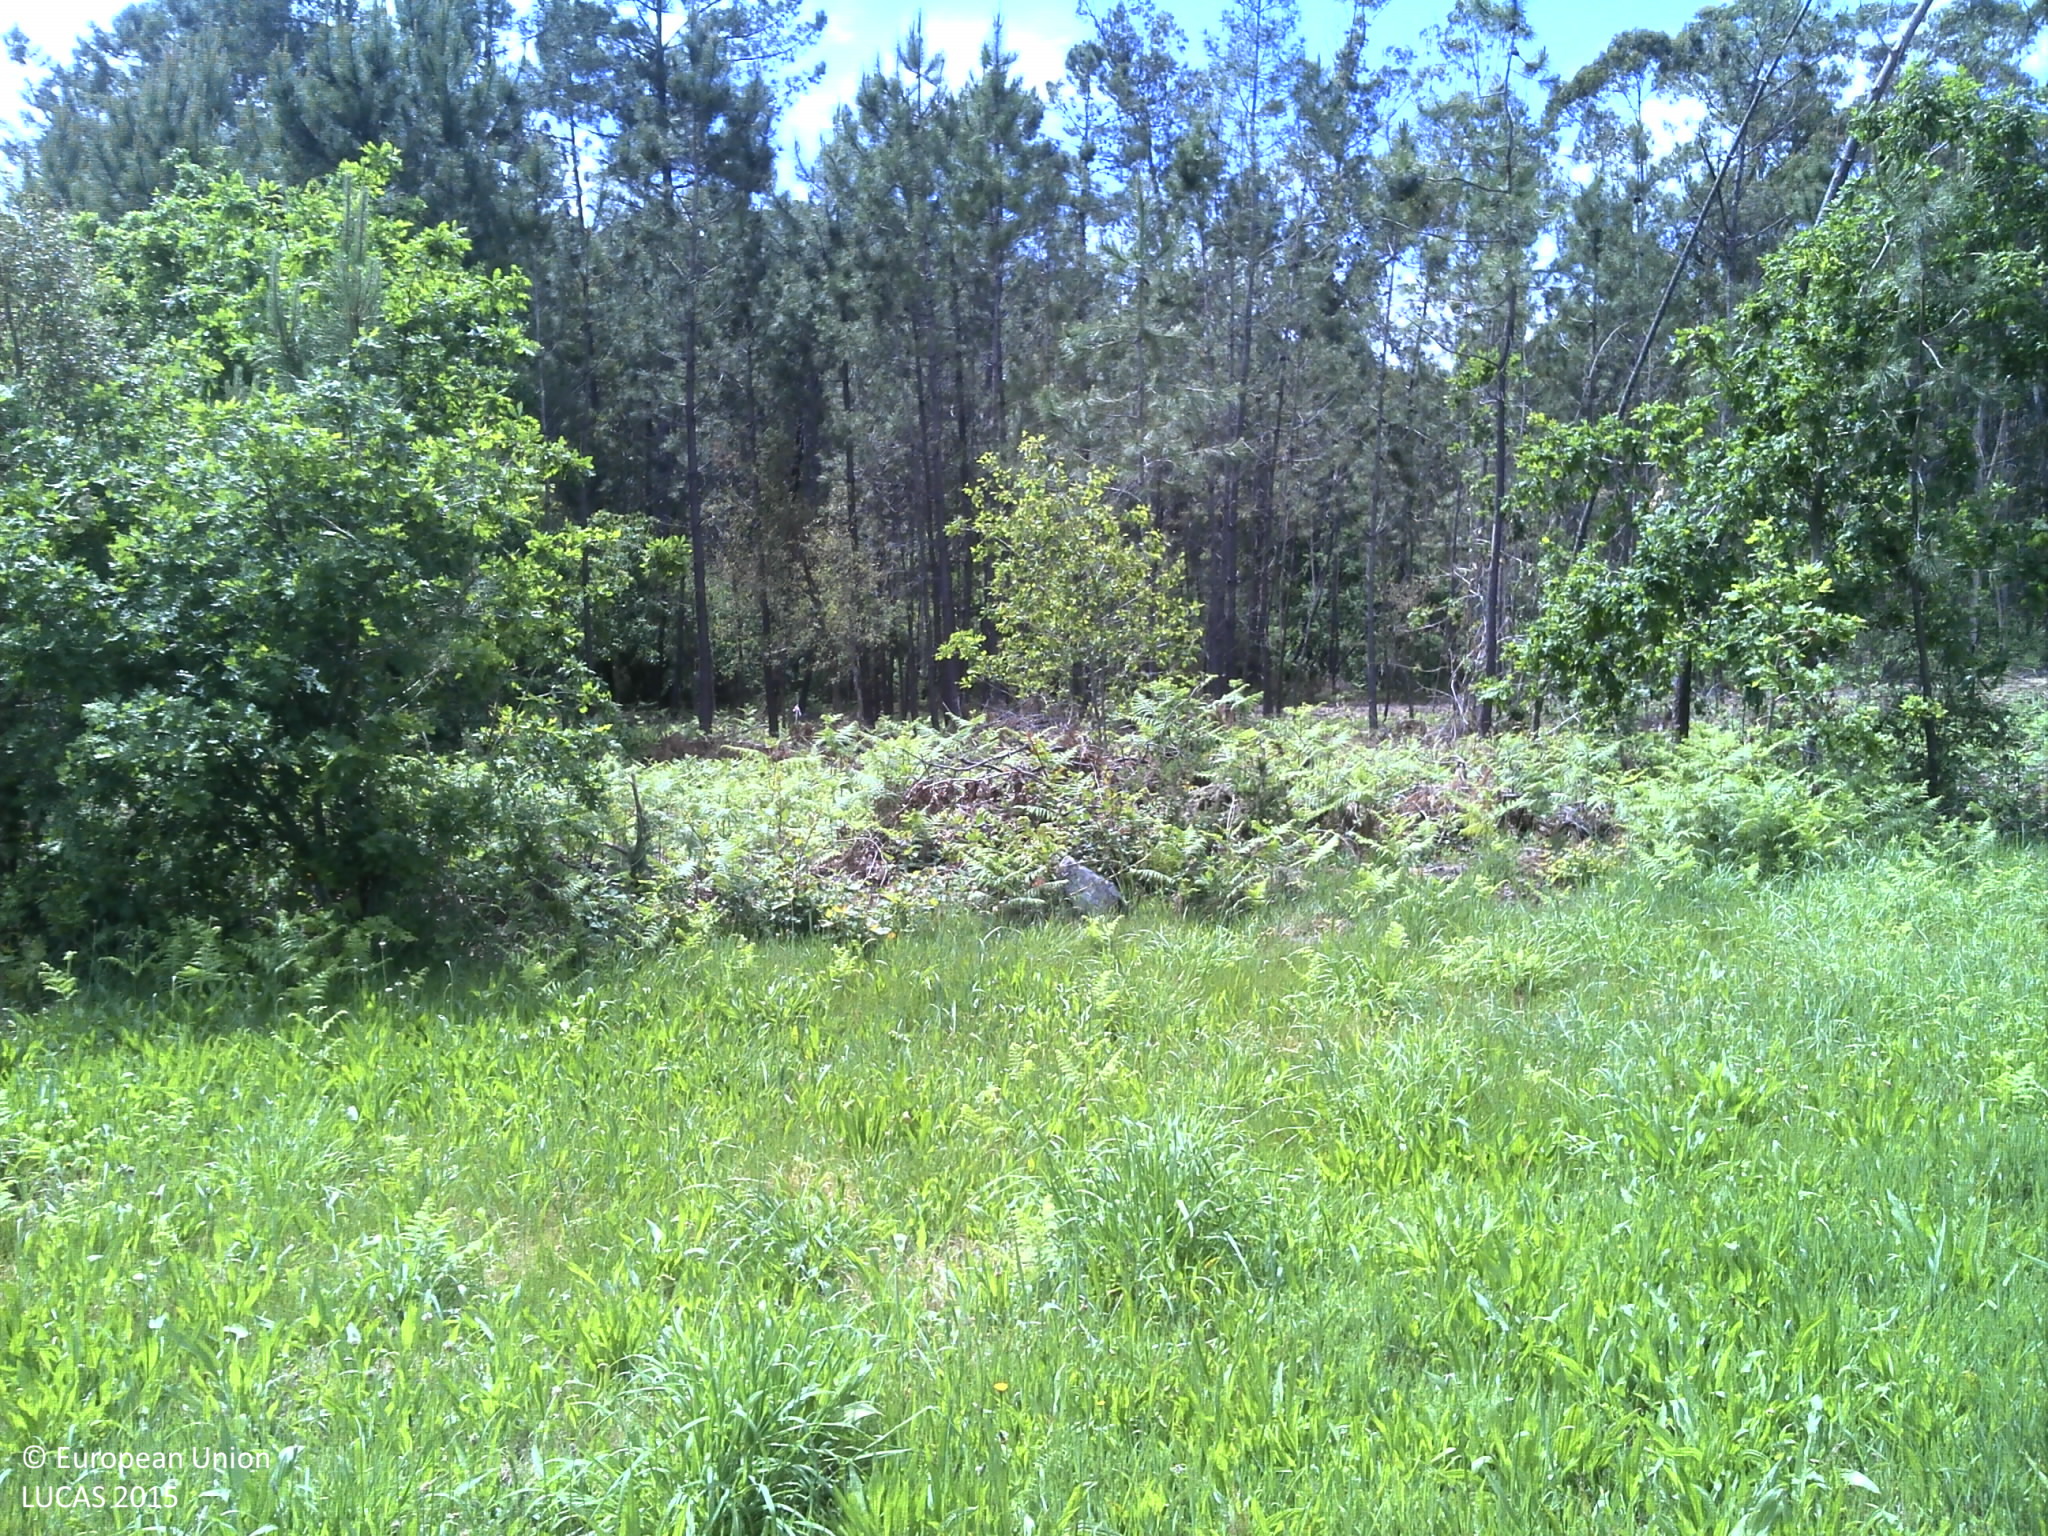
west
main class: Grassland
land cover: Spontaneously vegetated surfaces
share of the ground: > 75 %
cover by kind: herbaceous plants 90 %, unconsolidated bare surface 10 %
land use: Agriculture (excluding fallow land and kitchen gardens)
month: May
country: PT
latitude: 40.8982
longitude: -8.3862
